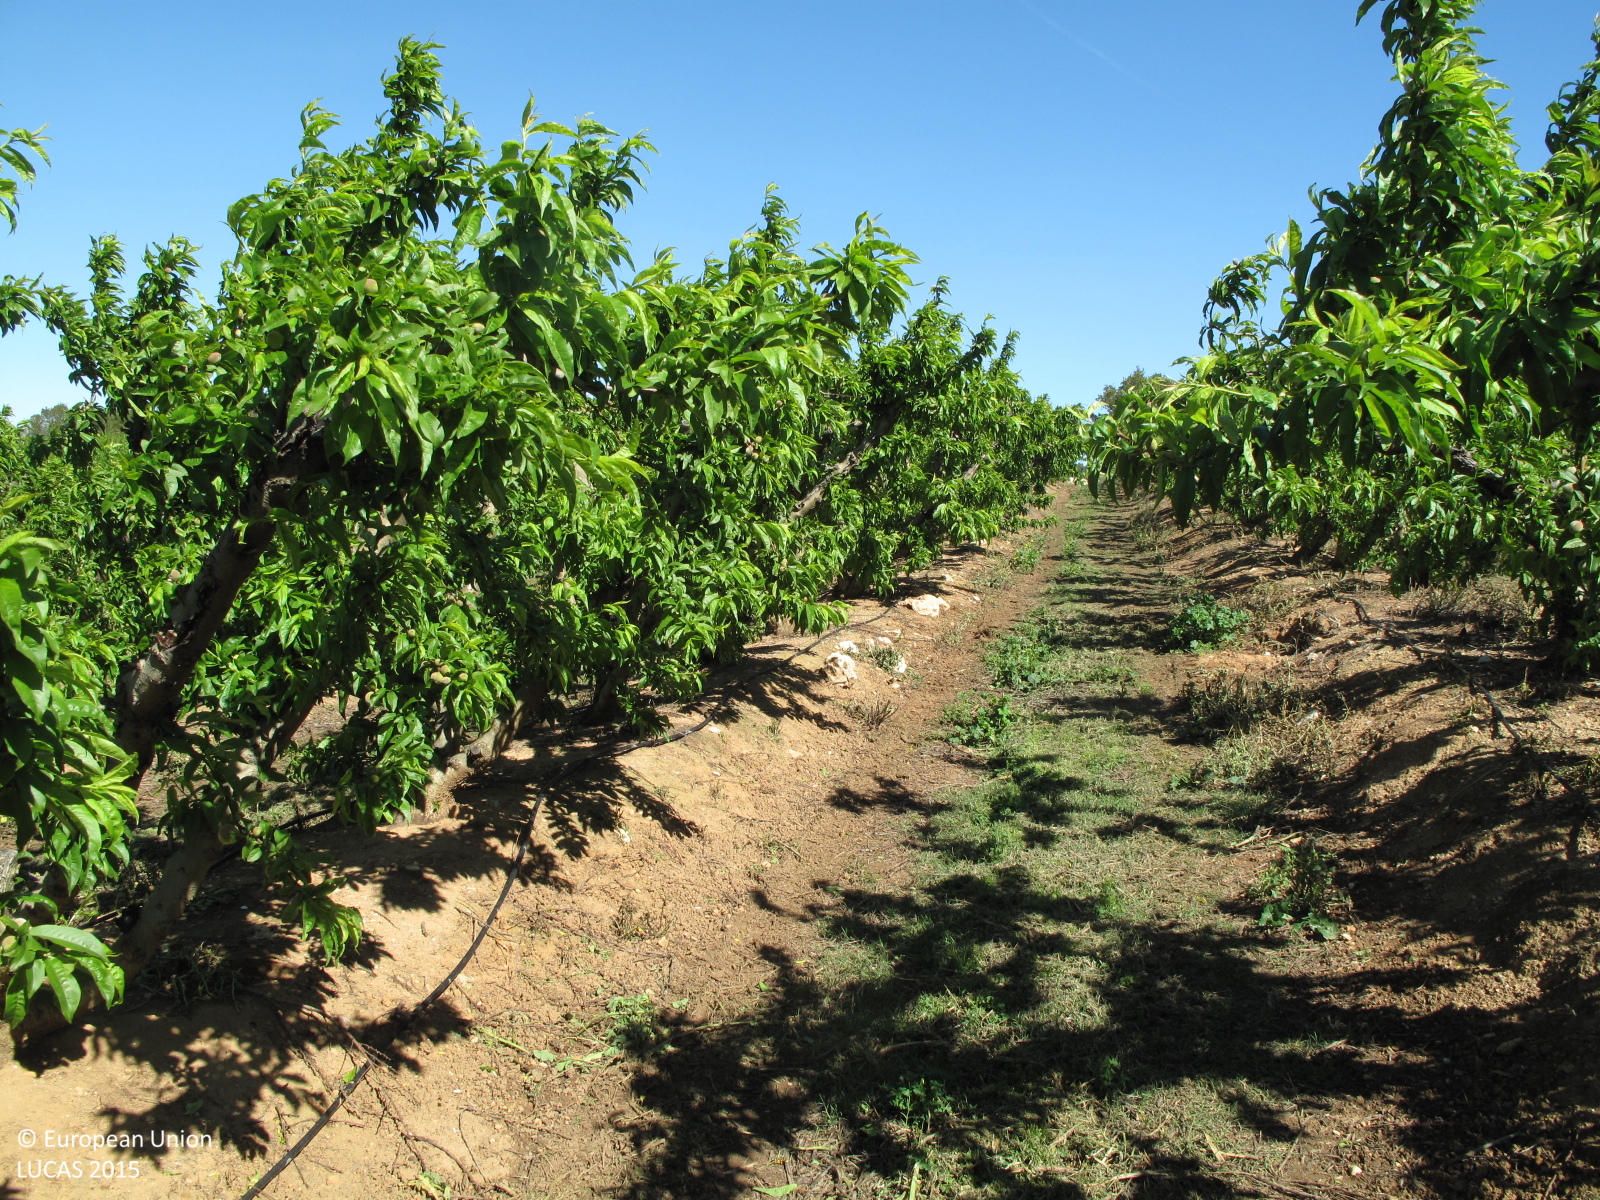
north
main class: Cropland
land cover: Other fruit trees and berries
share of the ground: > 75 %
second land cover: Spontaneously vegetated surfaces
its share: 25 - 50 %
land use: Agriculture (excluding fallow land and kitchen gardens)
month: March
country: ES
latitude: 39.1103
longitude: -0.5760
